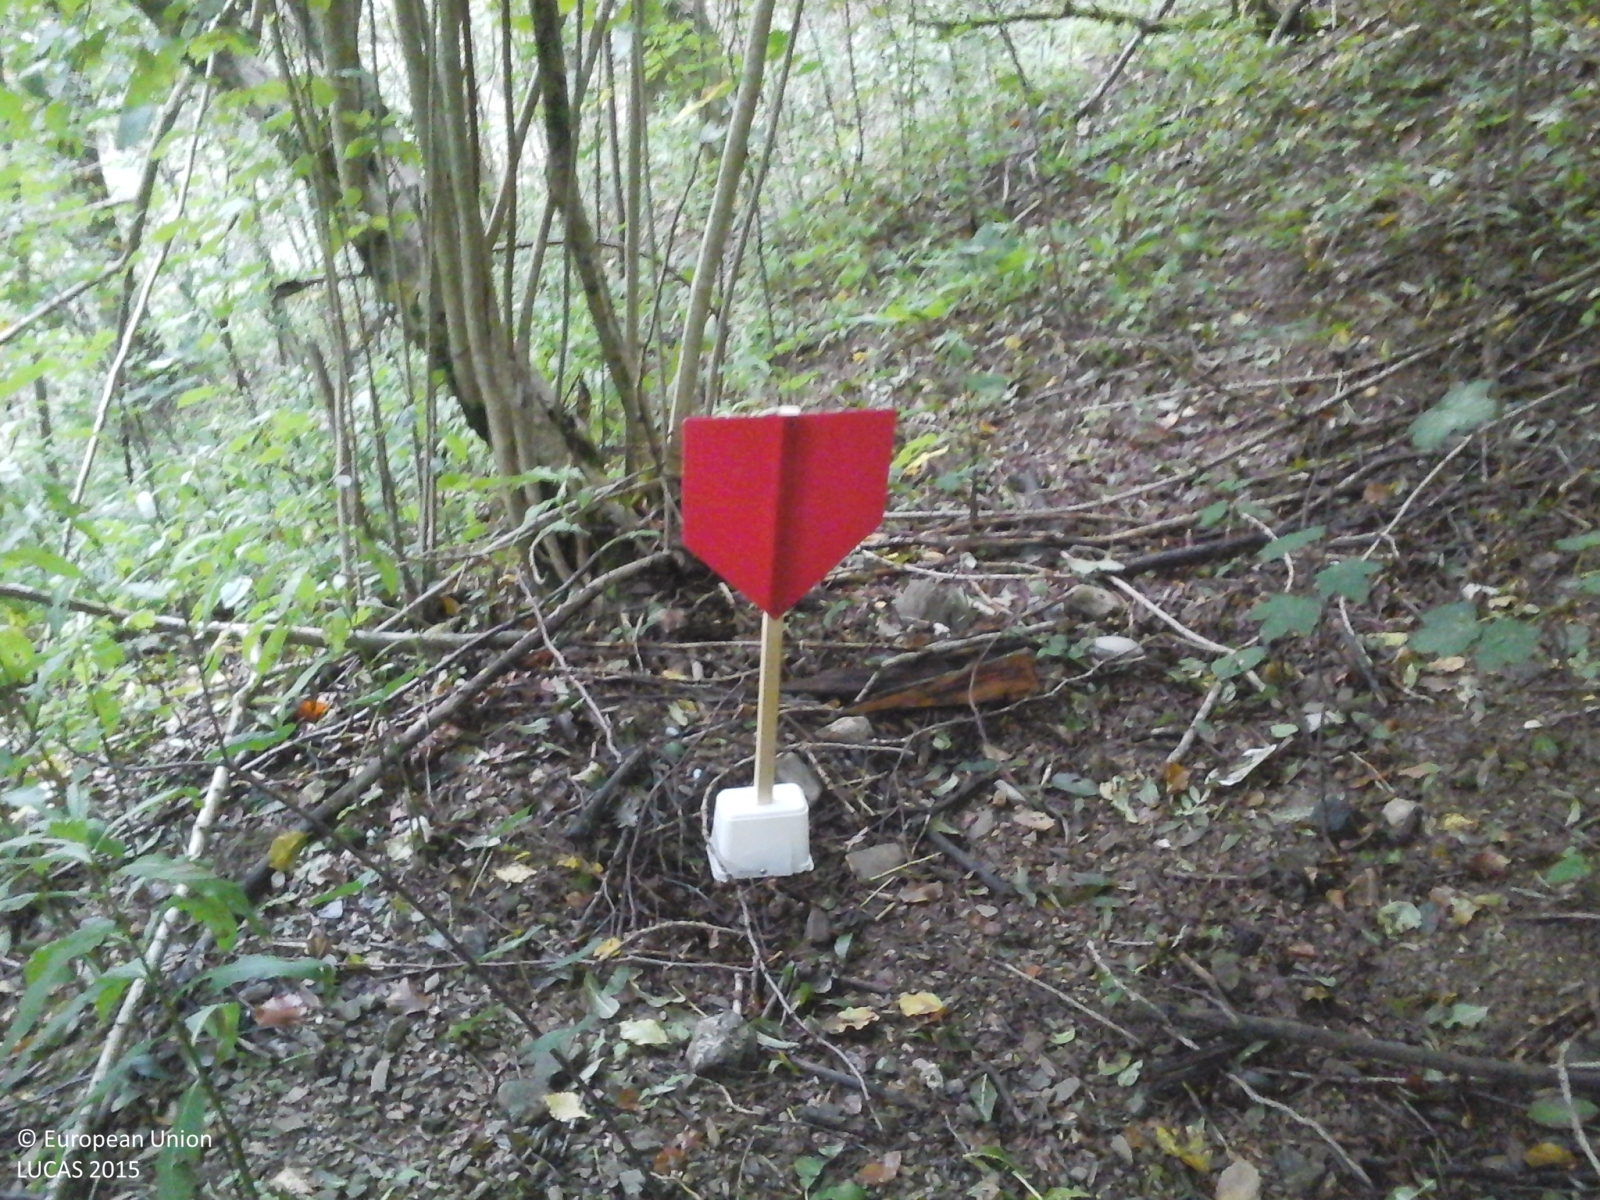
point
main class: Woodland
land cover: Broadleaved woodland
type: thermophilous deciduous forest
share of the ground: > 75 %
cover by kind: broadleaved forest trees 100 %
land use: Semi-natural and natural areas not in use
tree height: > 5 m
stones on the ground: 10 - 25 %
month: September
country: IT
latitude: 44.5099
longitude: 9.2093
